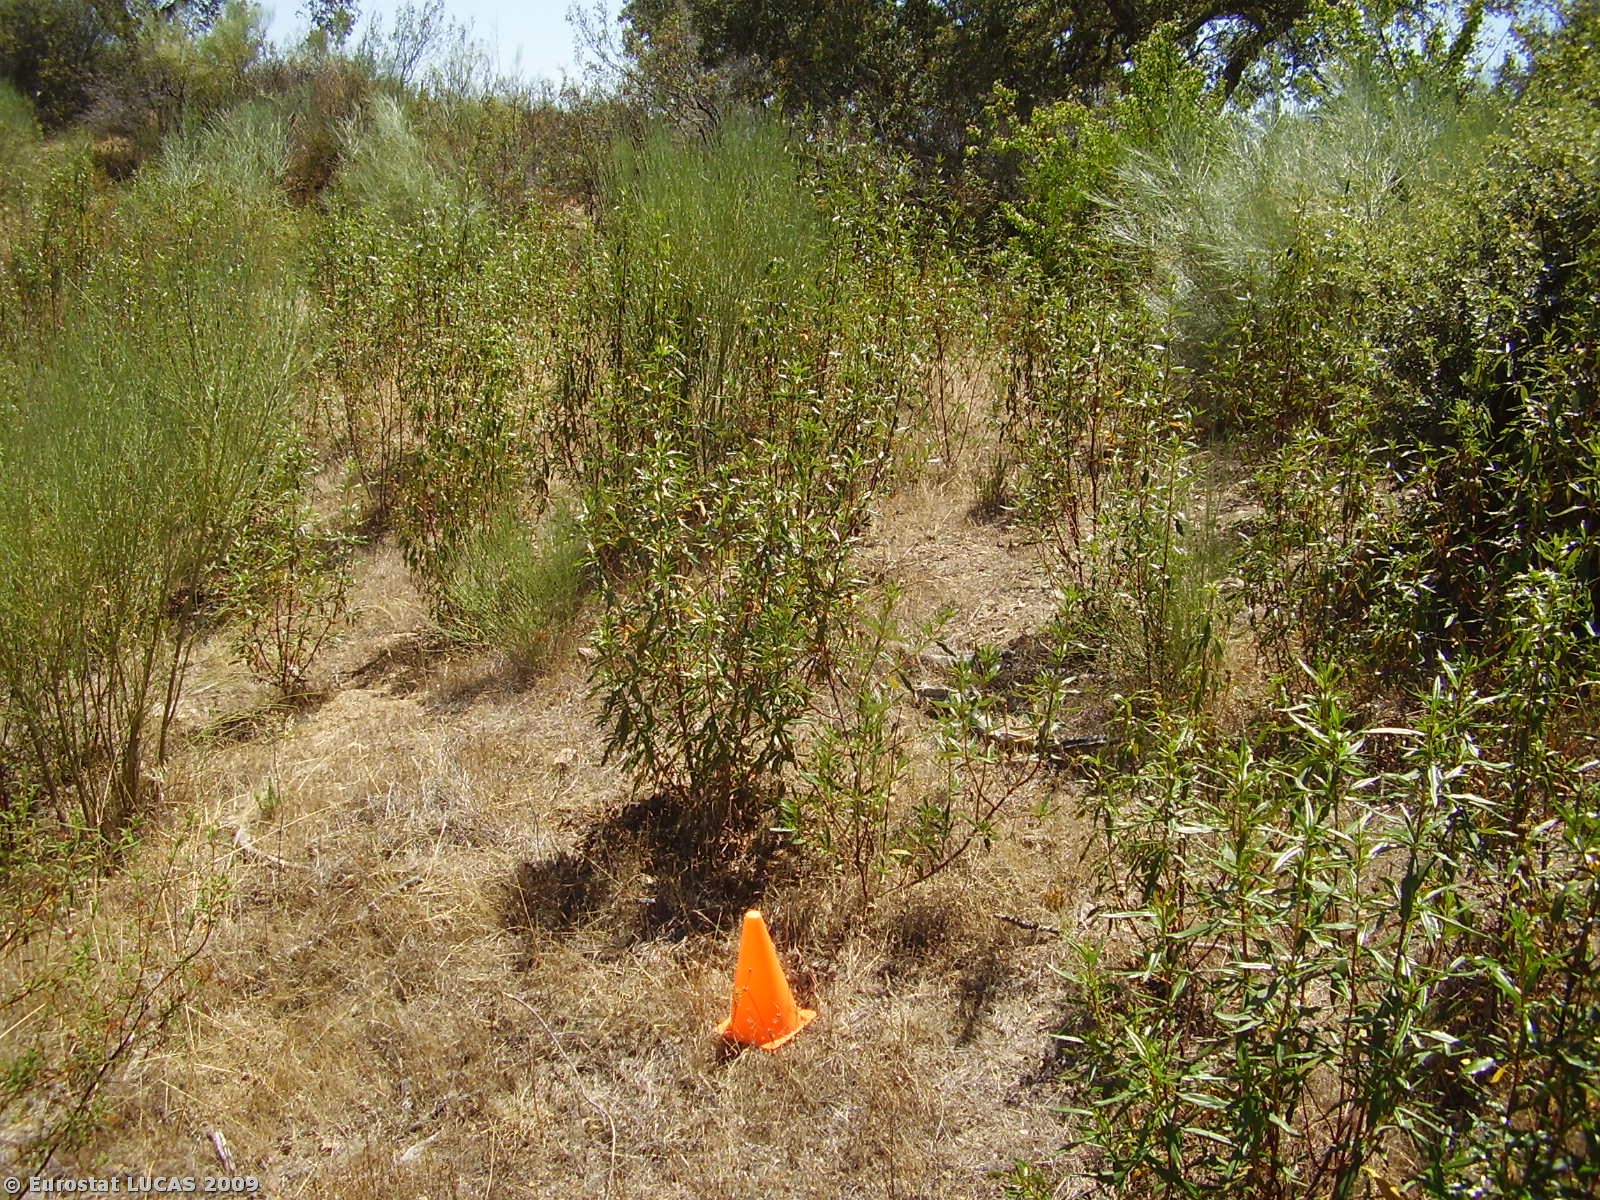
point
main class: Woodland
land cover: Broadleaved woodland
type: broadleaved evergreen forest
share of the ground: 25 - 50 %
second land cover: Shrubland with sparse tree cover
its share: 50 - 75 %
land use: Forestry
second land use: Fallow land
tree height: > 5 m
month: July
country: PT
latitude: 38.7541
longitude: -7.7012
